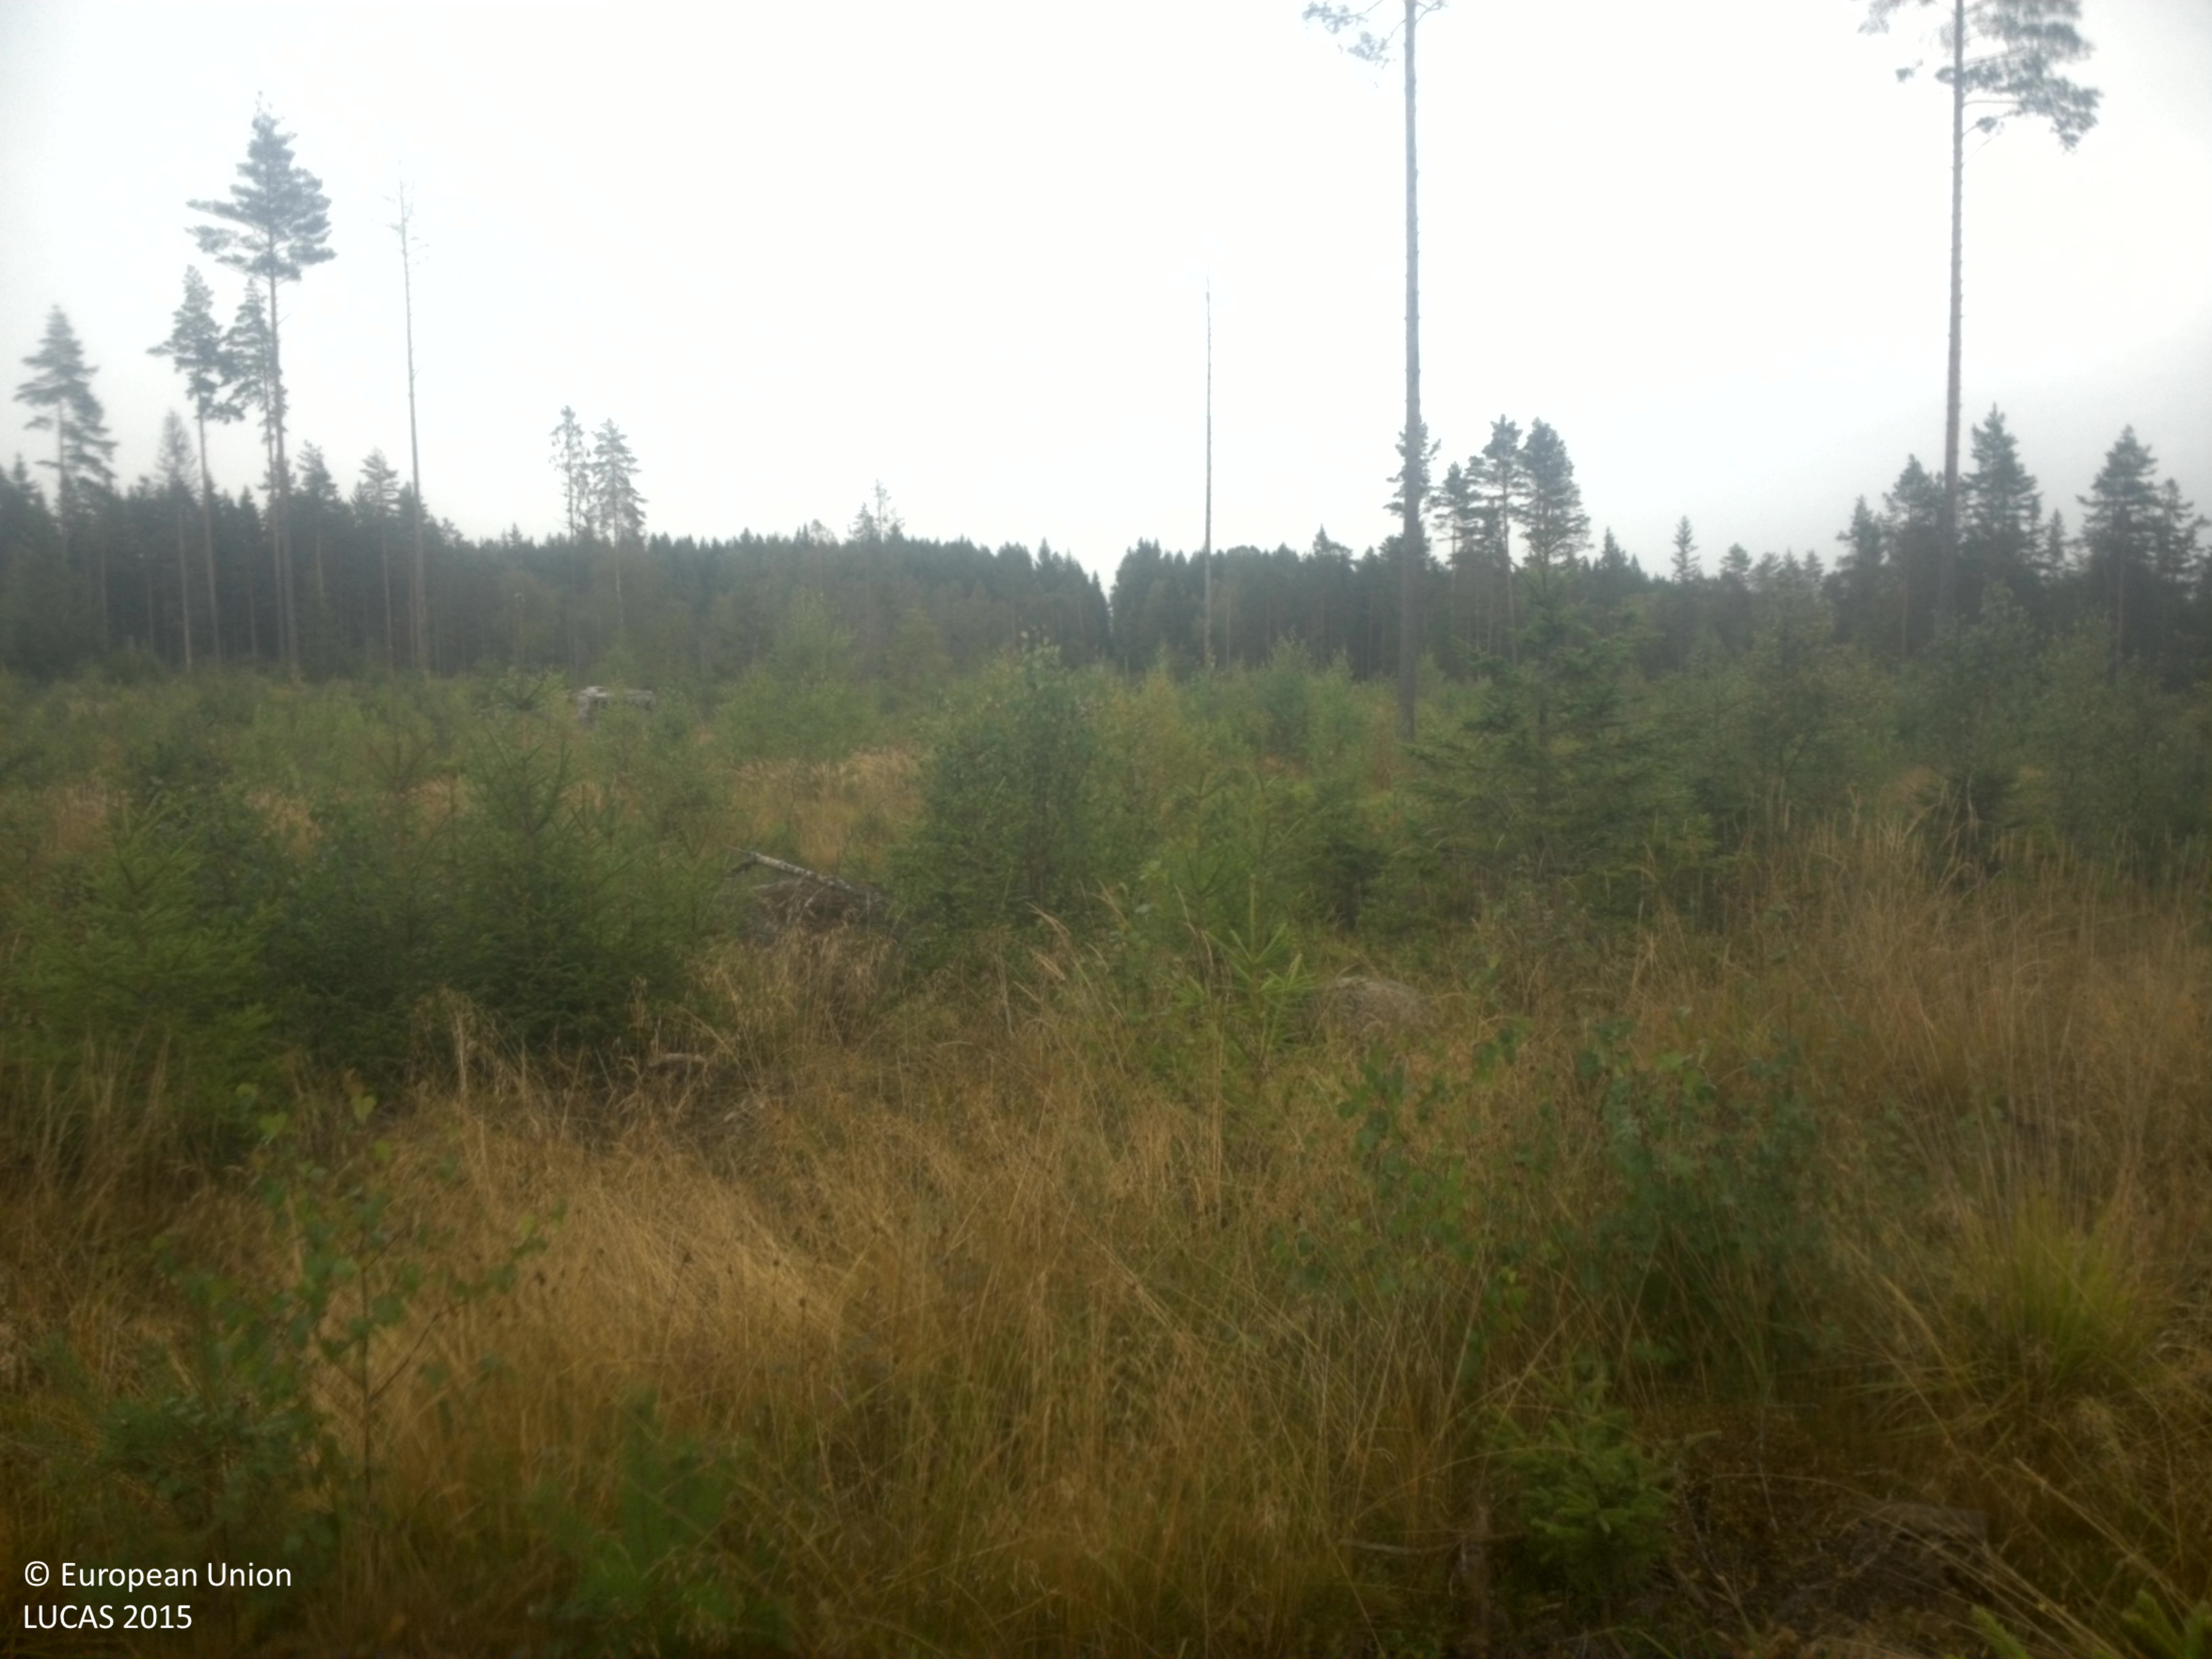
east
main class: Woodland
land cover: Pine dominated mixed woodland
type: boreal forest
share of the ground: 50 - 75 %
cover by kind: broadleaved forest trees 30 %, herbaceous plants 30 %, coniferous forest trees 20 %, shrubs 15 %, unconsolidated bare surface 5 %
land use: Forestry
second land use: Amenities, museums, leisure
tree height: < 5 m
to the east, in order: Pine dominated mixed woodland; Spruce dominated coniferous woodland; Pine dominated mixed woodland; Rivers and streams; Inland marshes; Pine dominated mixed woodland
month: September
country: SE
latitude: 59.6688
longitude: 15.6894
